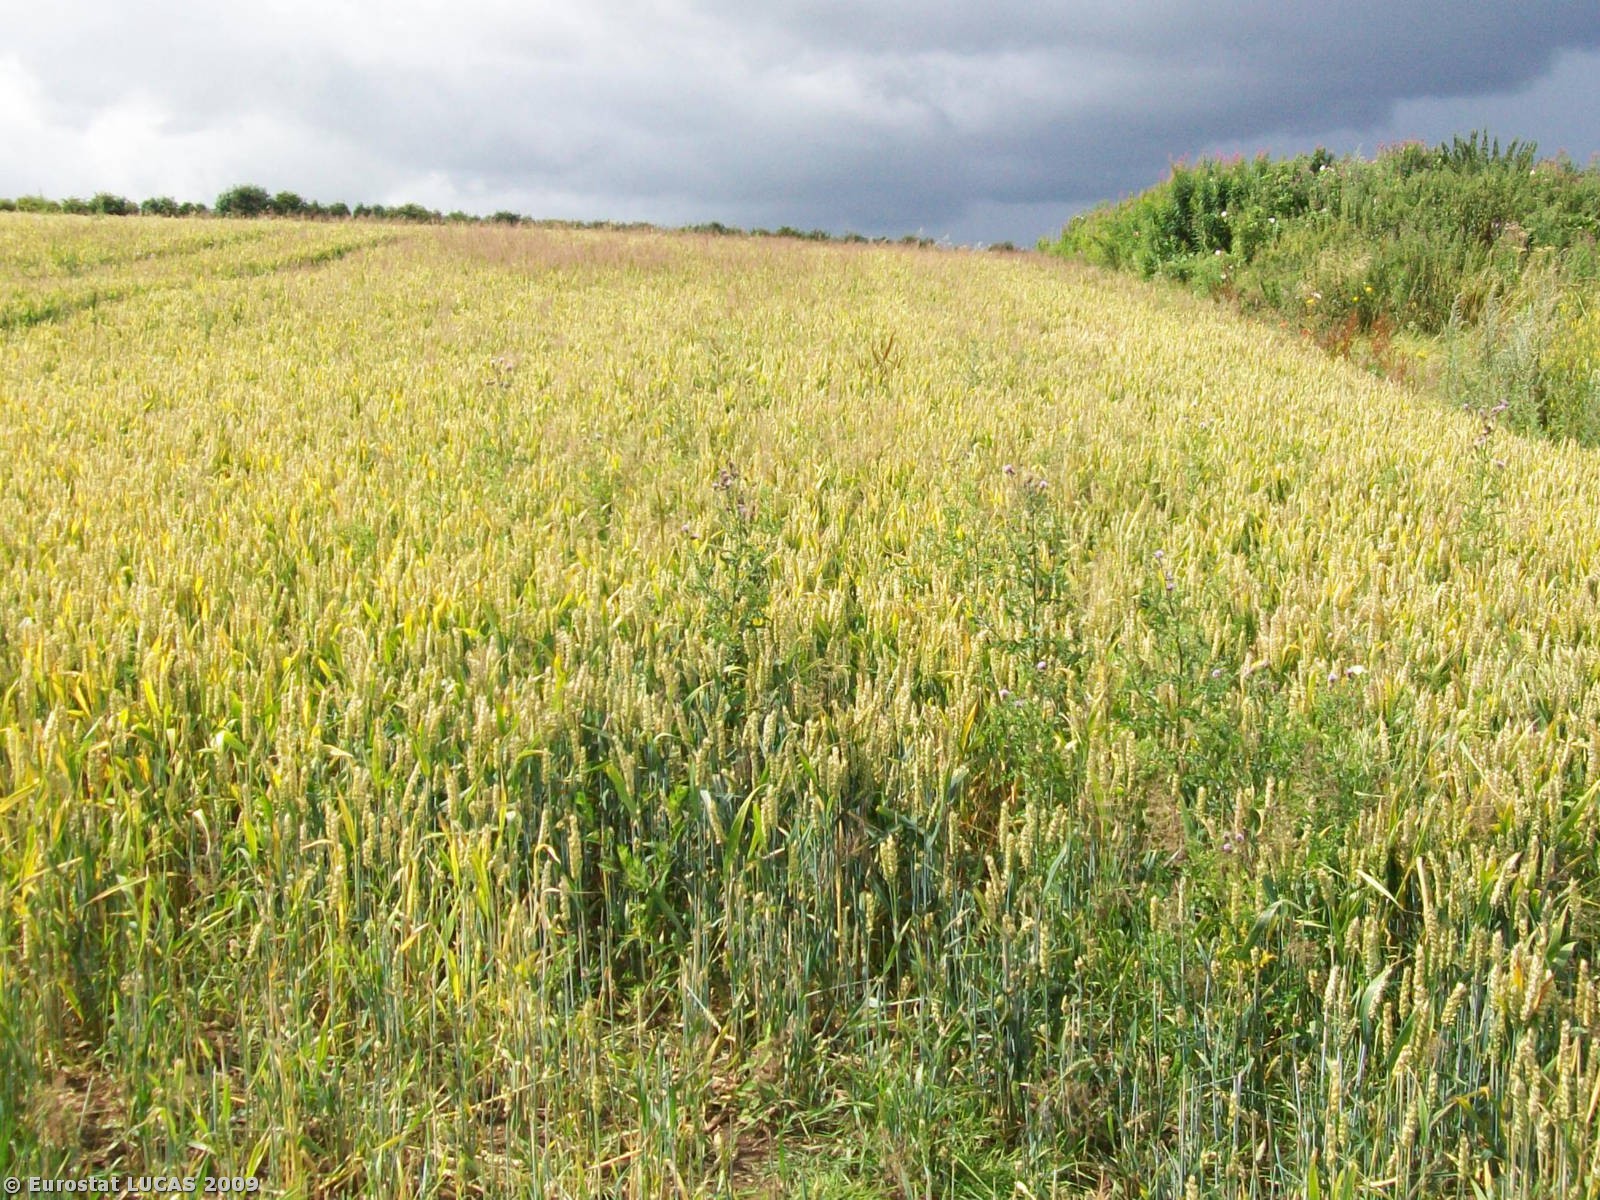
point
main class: Cropland
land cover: Common wheat
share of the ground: > 75 %
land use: Agriculture (excluding fallow land and kitchen gardens)
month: July
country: GB
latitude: 53.2223
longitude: -1.2351
